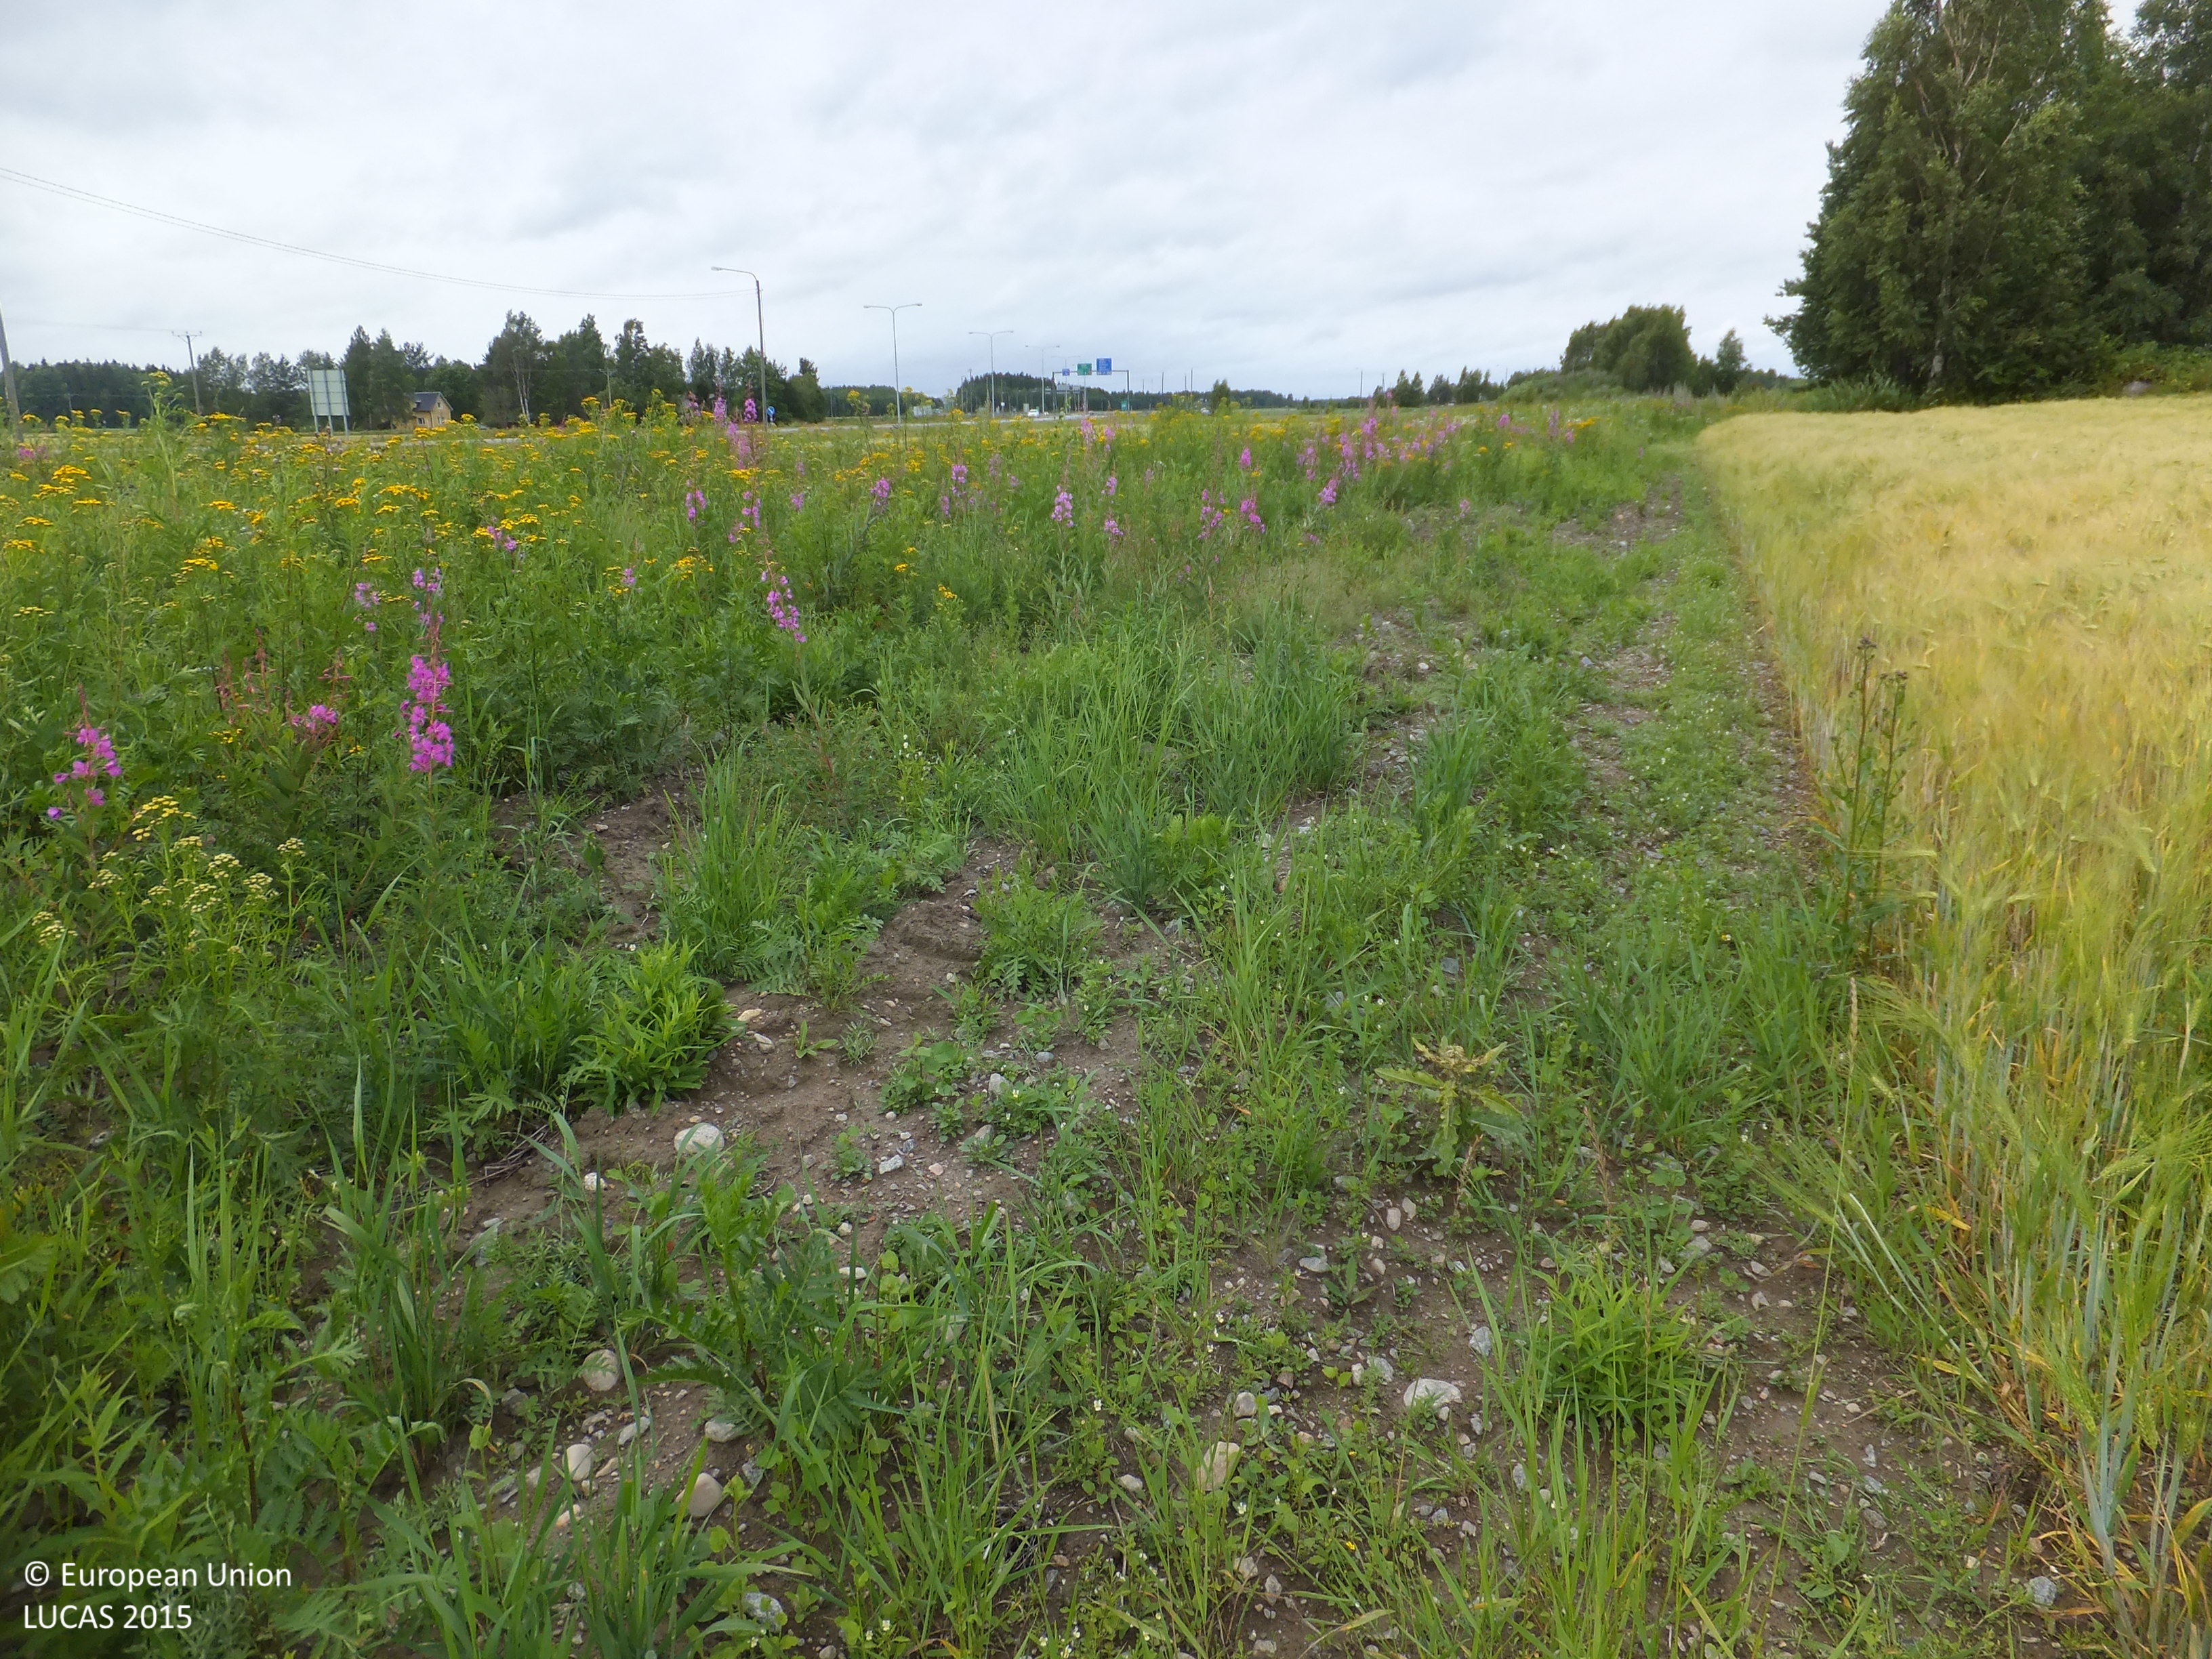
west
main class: Cropland
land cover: Barley
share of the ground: > 75 %
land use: Agriculture (excluding fallow land and kitchen gardens)
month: July
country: FI
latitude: 63.0238
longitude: 21.7997
